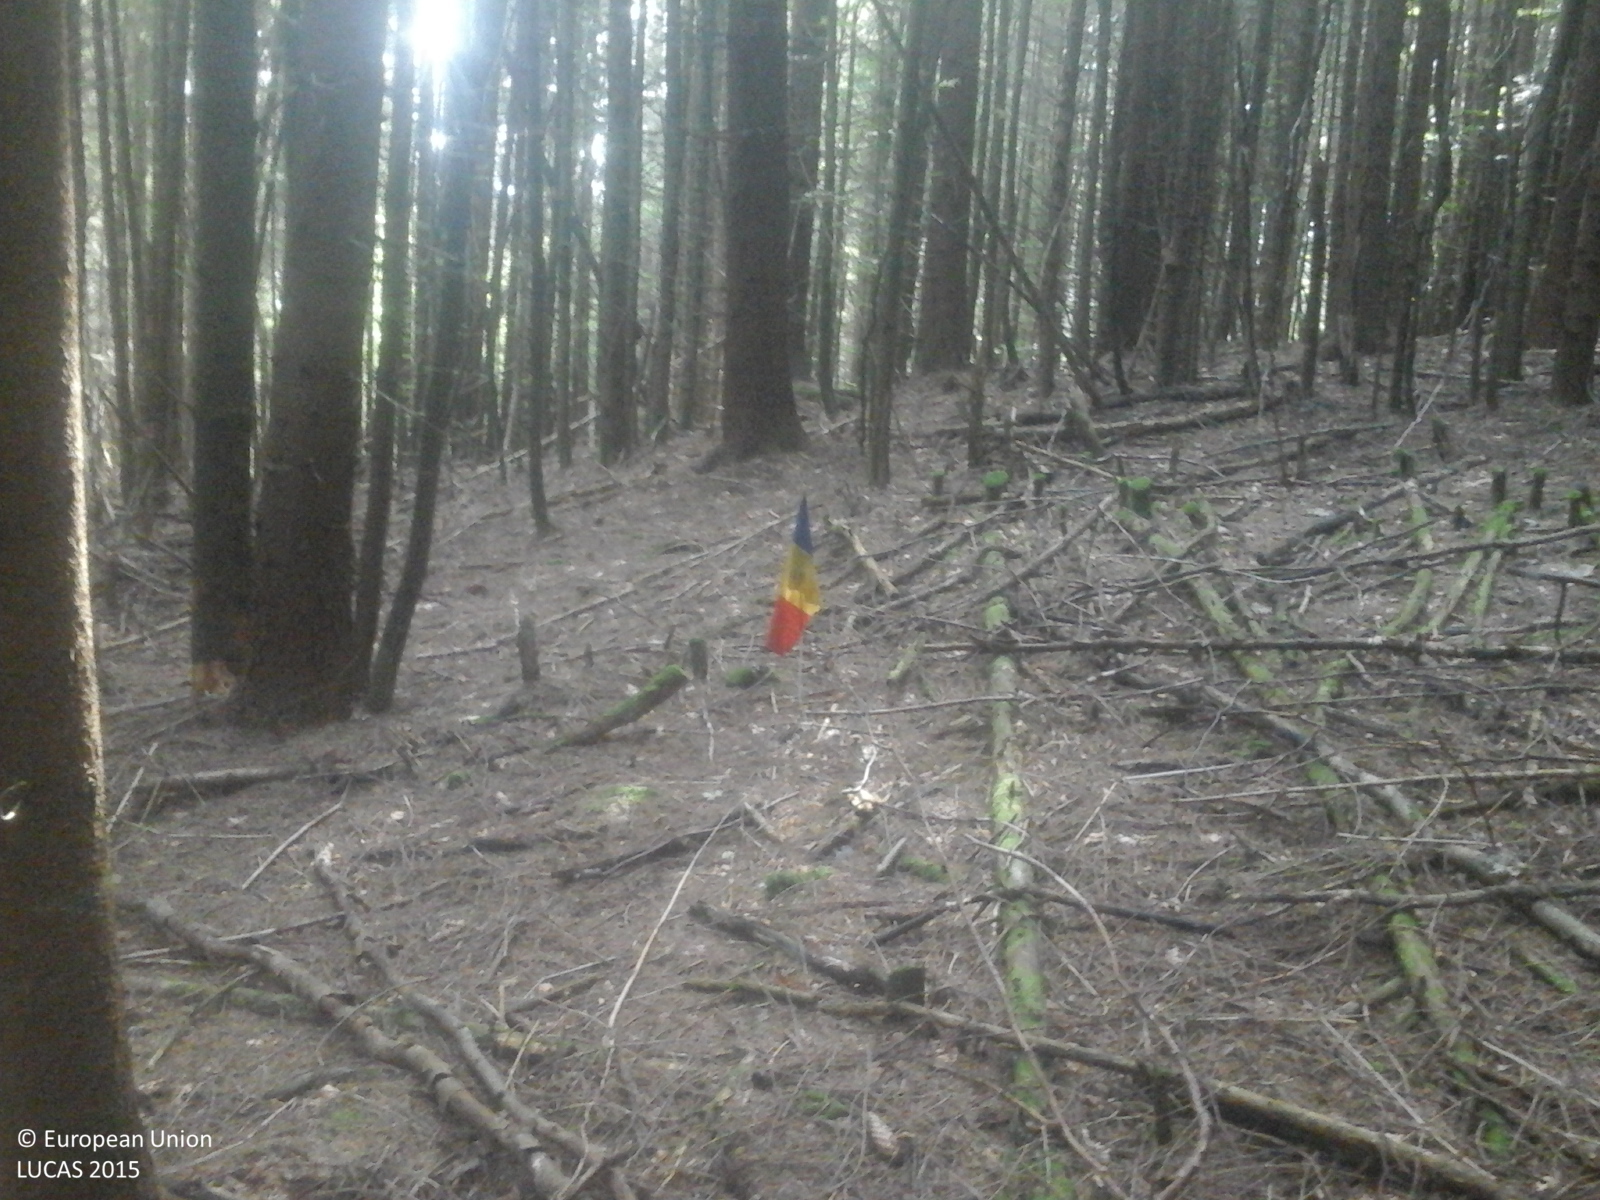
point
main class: Woodland
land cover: Spruce dominated coniferous woodland
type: alpine coniferous forest
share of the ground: > 75 %
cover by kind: coniferous forest trees 100 %
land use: Forestry
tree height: > 5 m
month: September
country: RO
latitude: 46.7965
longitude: 22.6726
